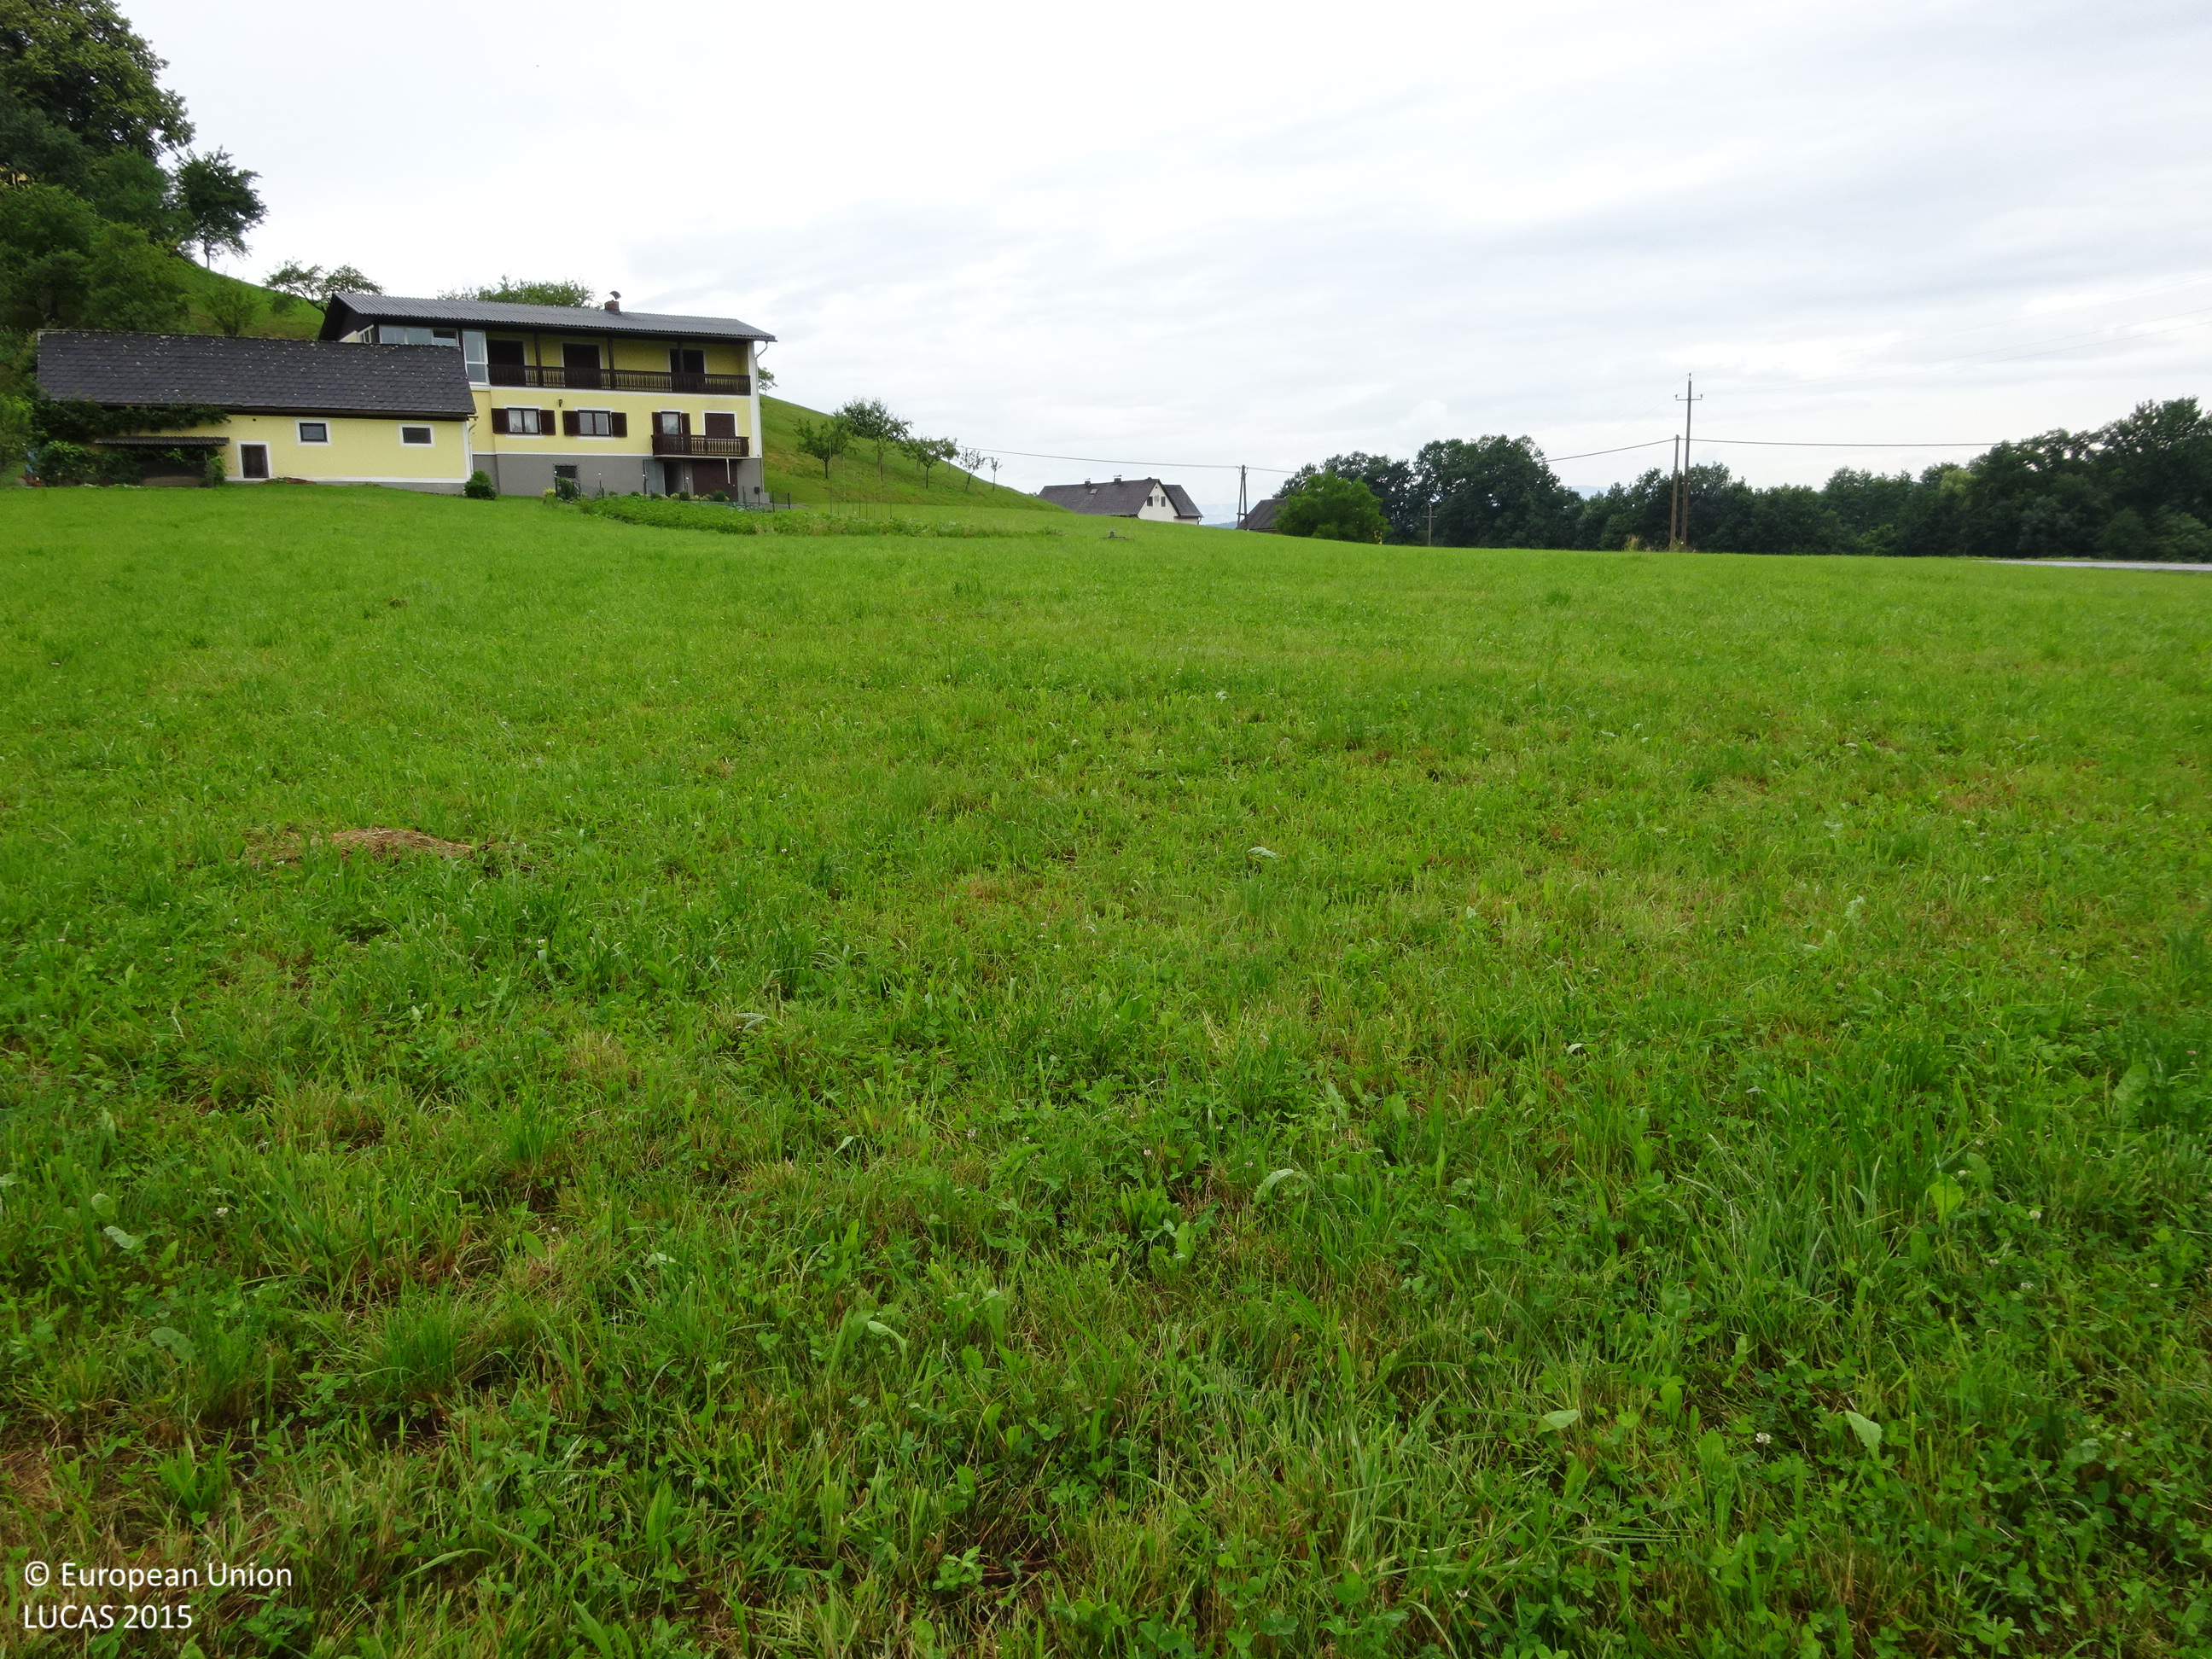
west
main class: Grassland
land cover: Grassland without tree/shrub cover
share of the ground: > 75 %
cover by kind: herbaceous plants 100 %
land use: Agriculture (excluding fallow land and kitchen gardens)
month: June
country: AT
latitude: 46.7560
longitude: 15.4060
